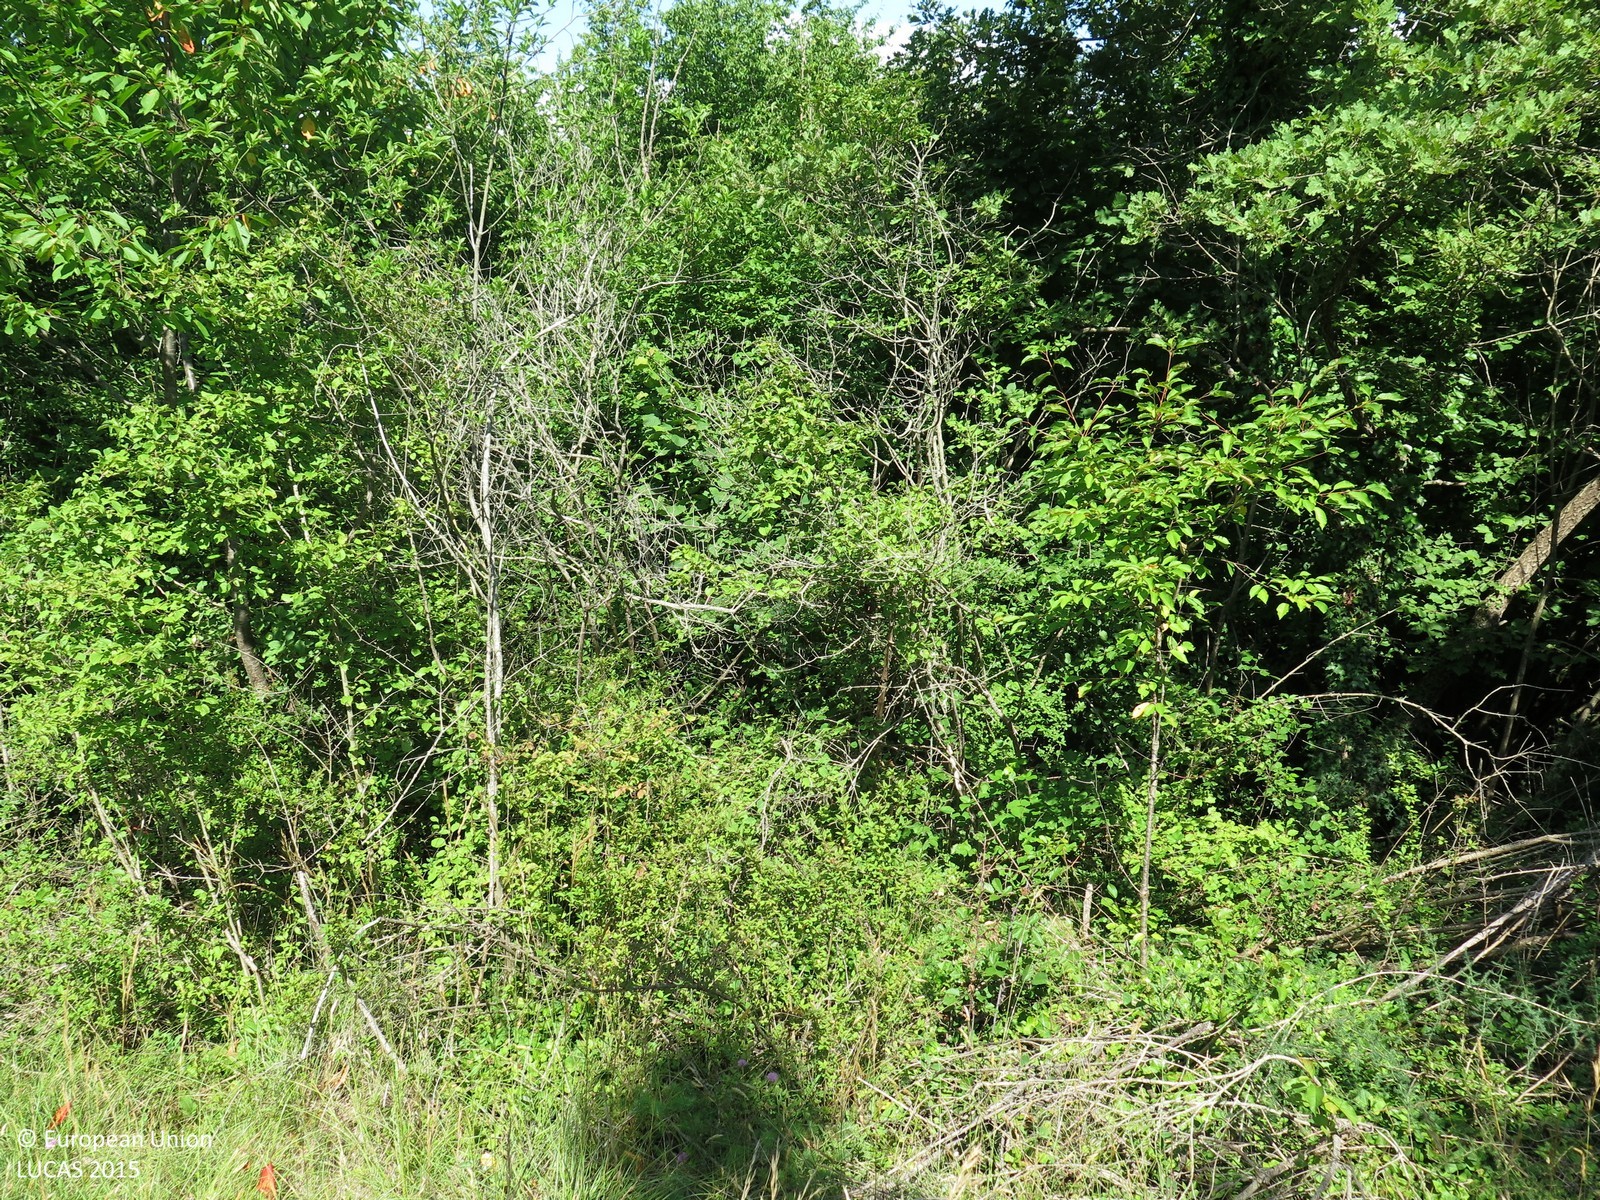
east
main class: Woodland
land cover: Broadleaved woodland
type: mesophytic deciduous forest
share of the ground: > 75 %
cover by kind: broadleaved forest trees 90 %, shrubs 5 %, herbaceous plants 5 %
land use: Semi-natural and natural areas not in use
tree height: > 5 m
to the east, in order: Broadleaved woodland; Temporary grasslands; Broadleaved woodland; Grass margins; Paved roads, cycling and walking lanes; Grass margins; Grassland with sparse tree/shrub cover; Shrubland with sparse tree cover; Oats
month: June
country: HR
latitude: 45.2393
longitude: 13.7529
